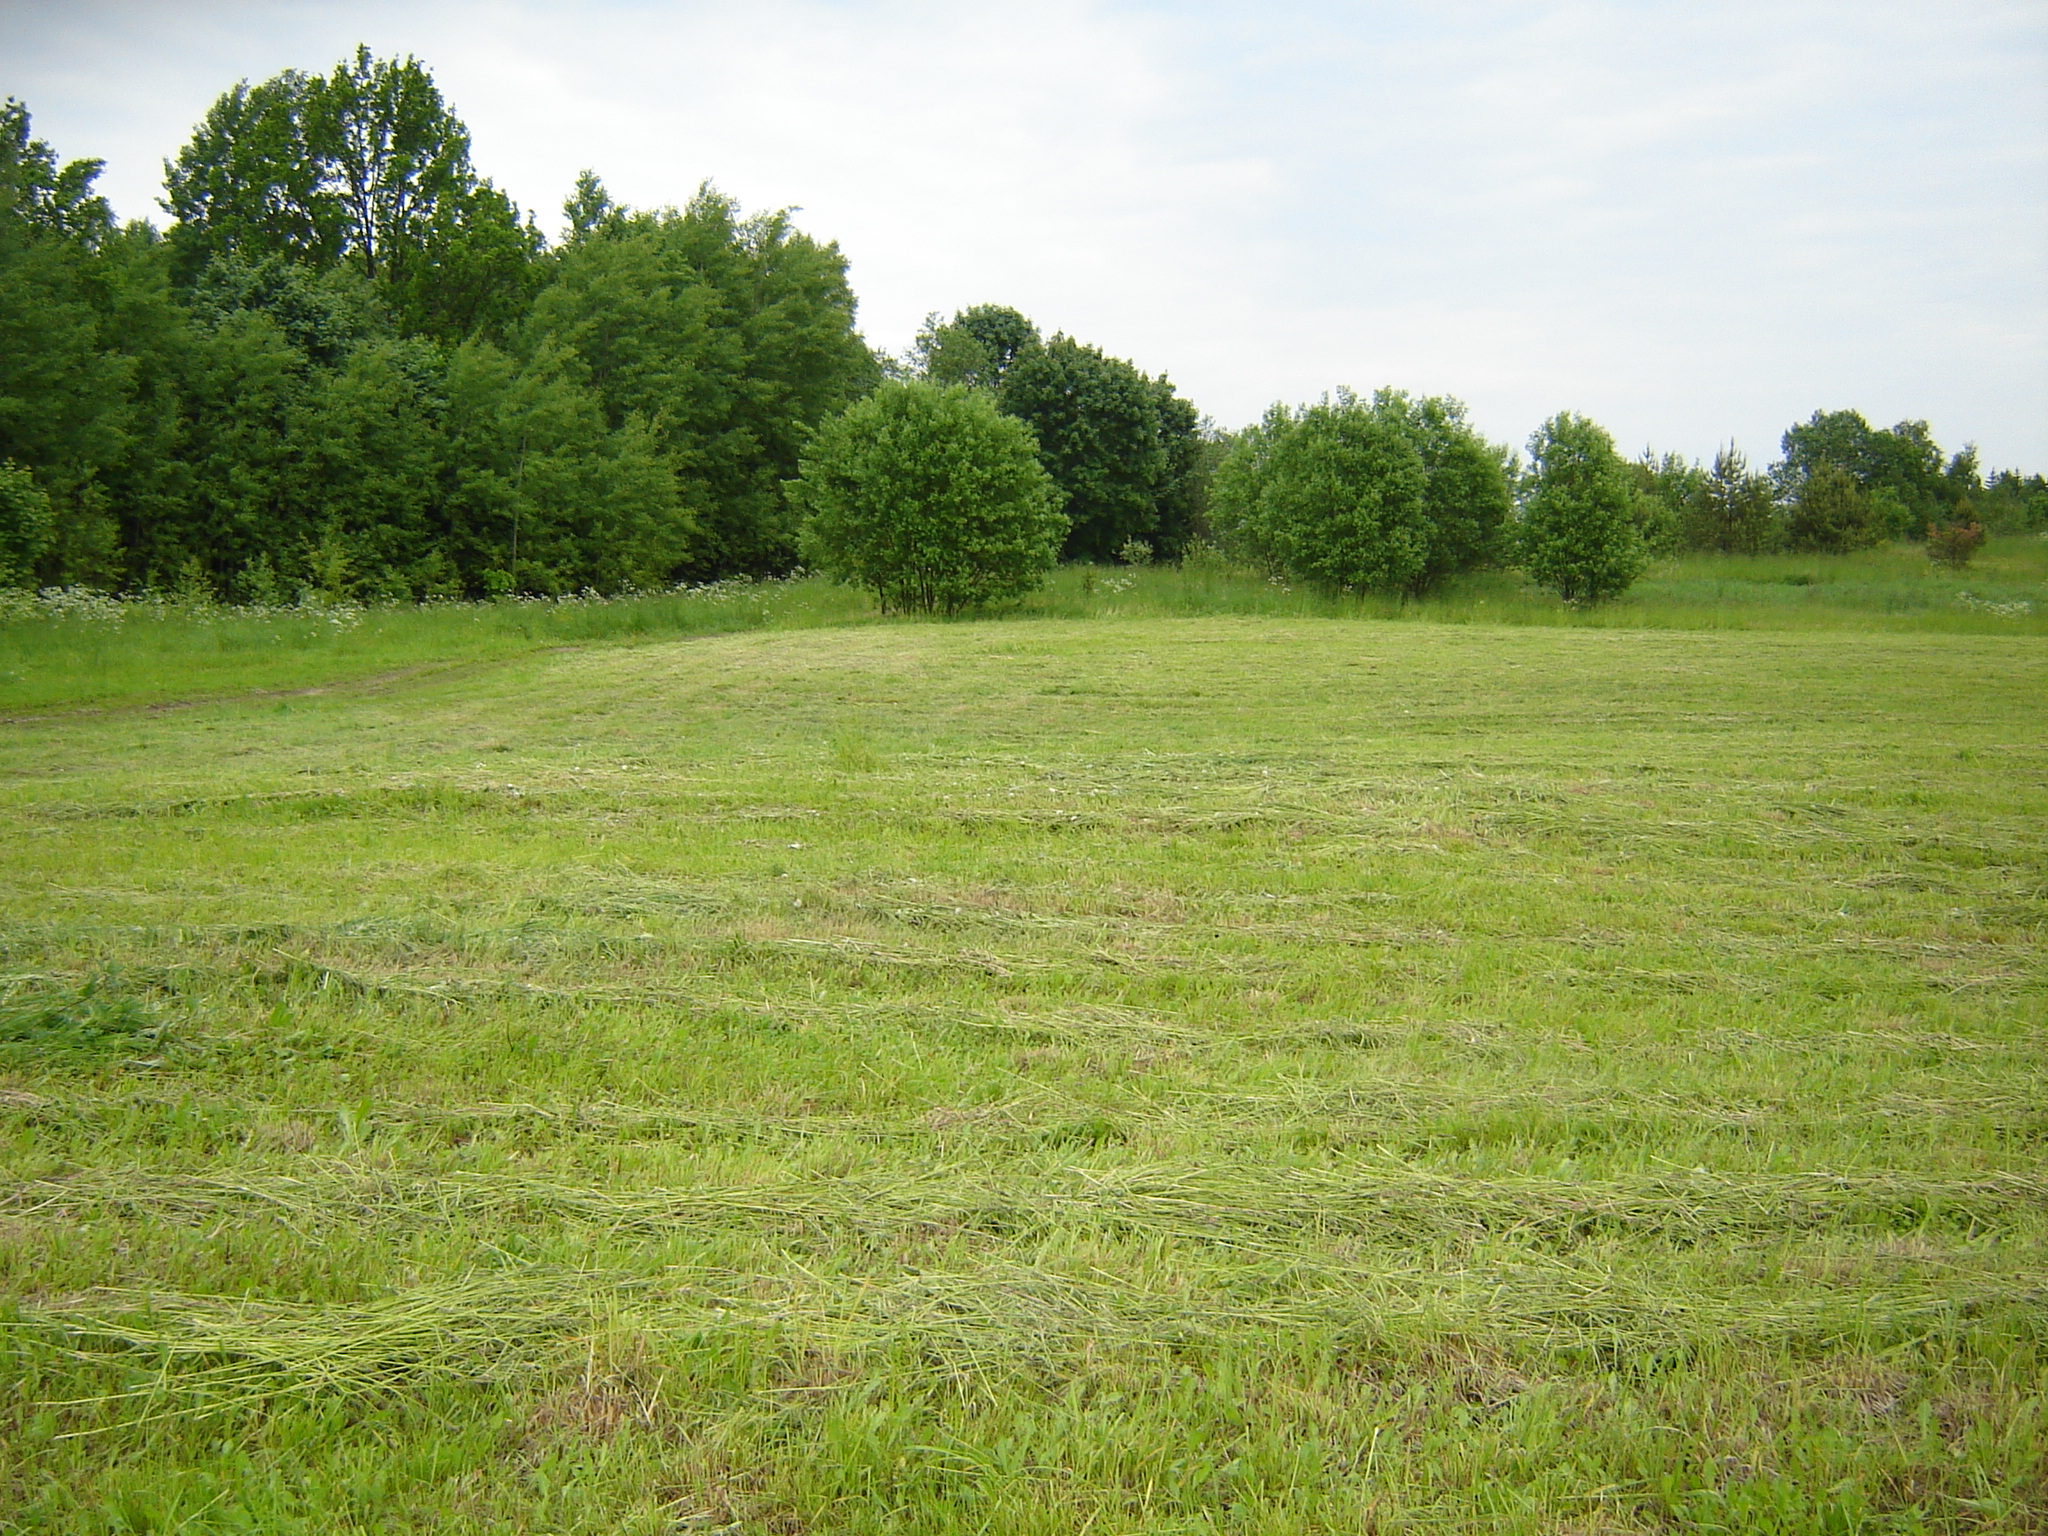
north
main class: Grassland
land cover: Grassland without tree/shrub cover
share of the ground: > 75 %
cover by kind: herbaceous plants 100 %
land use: Agriculture (excluding fallow land and kitchen gardens)
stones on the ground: < 10 %
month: June
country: LT
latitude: 55.7923
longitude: 25.6129
